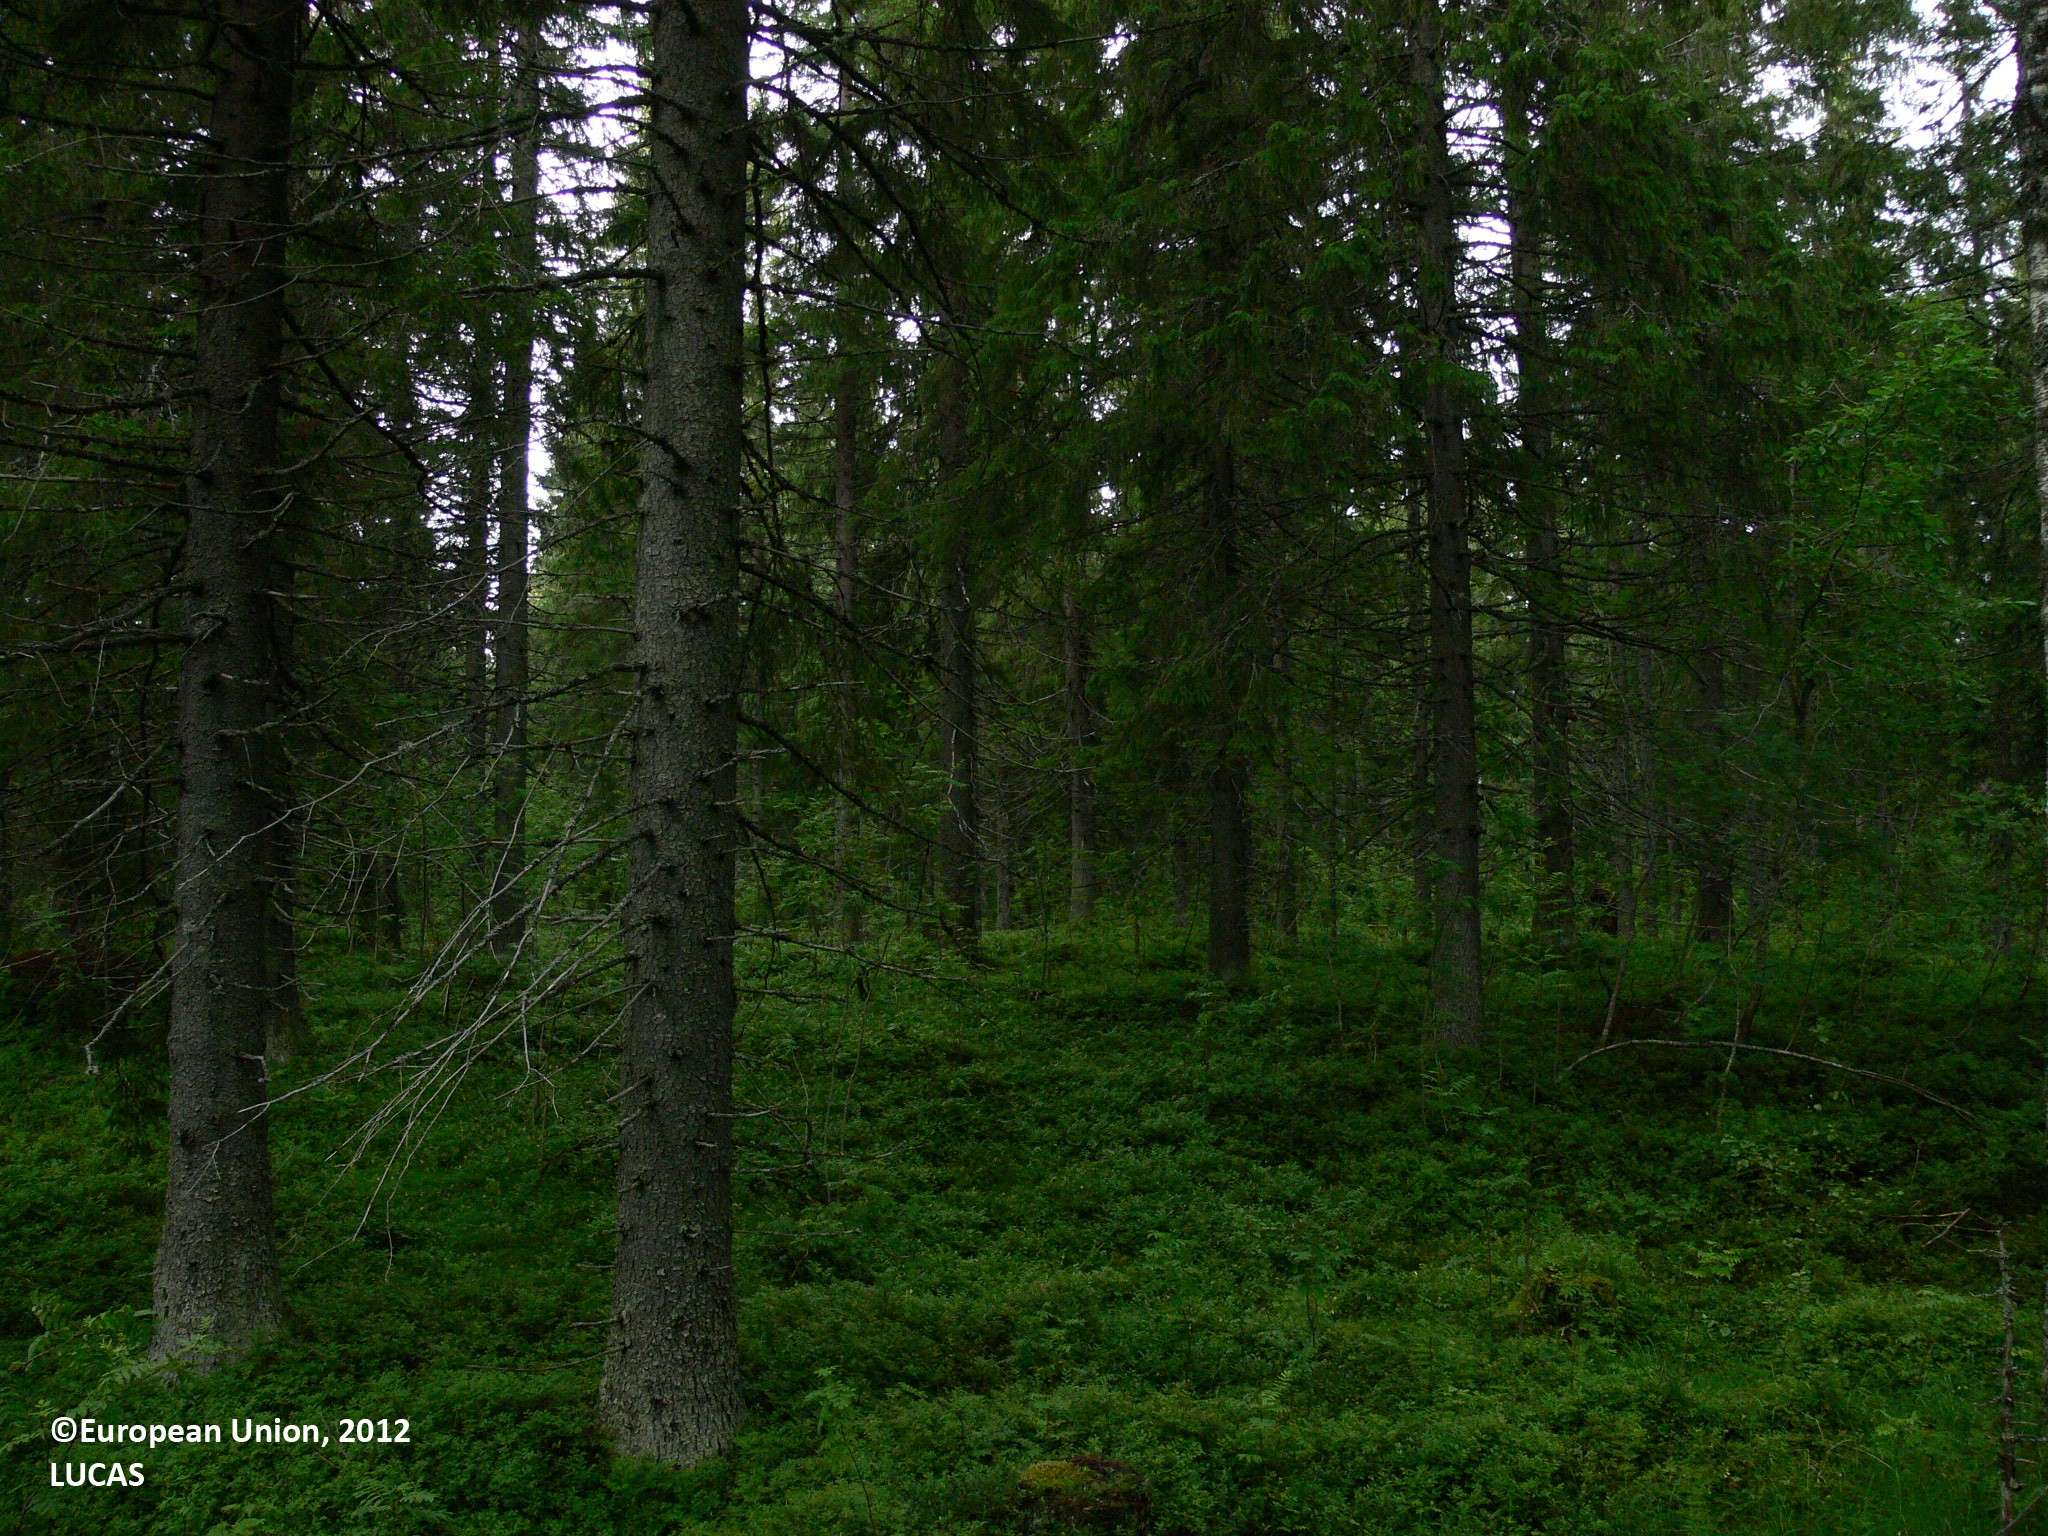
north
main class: Woodland
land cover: Spruce dominated coniferous woodland
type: boreal forest
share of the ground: > 75 %
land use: Forestry
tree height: > 5 m
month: July
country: FI
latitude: 63.1315
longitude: 29.2000
